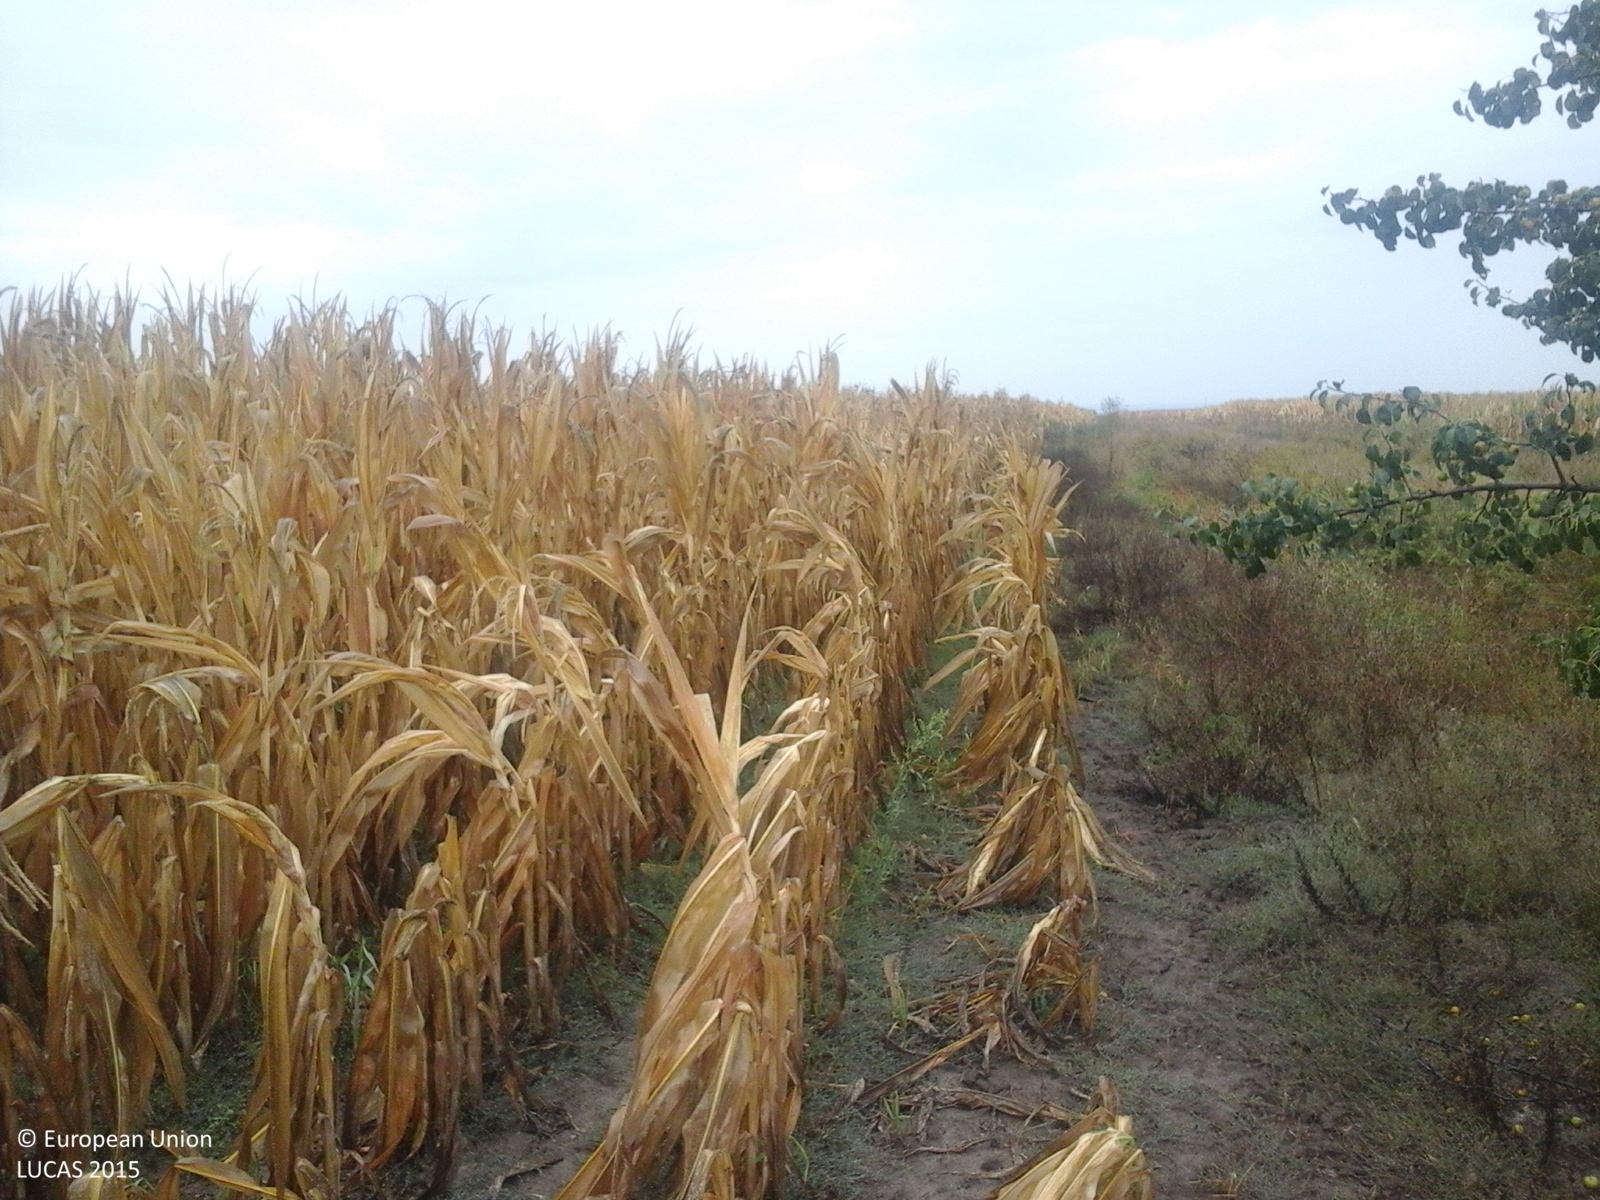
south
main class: Cropland
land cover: Maize
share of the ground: > 75 %
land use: Agriculture (excluding fallow land and kitchen gardens)
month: September
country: RO
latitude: 47.5884
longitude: 22.5985
